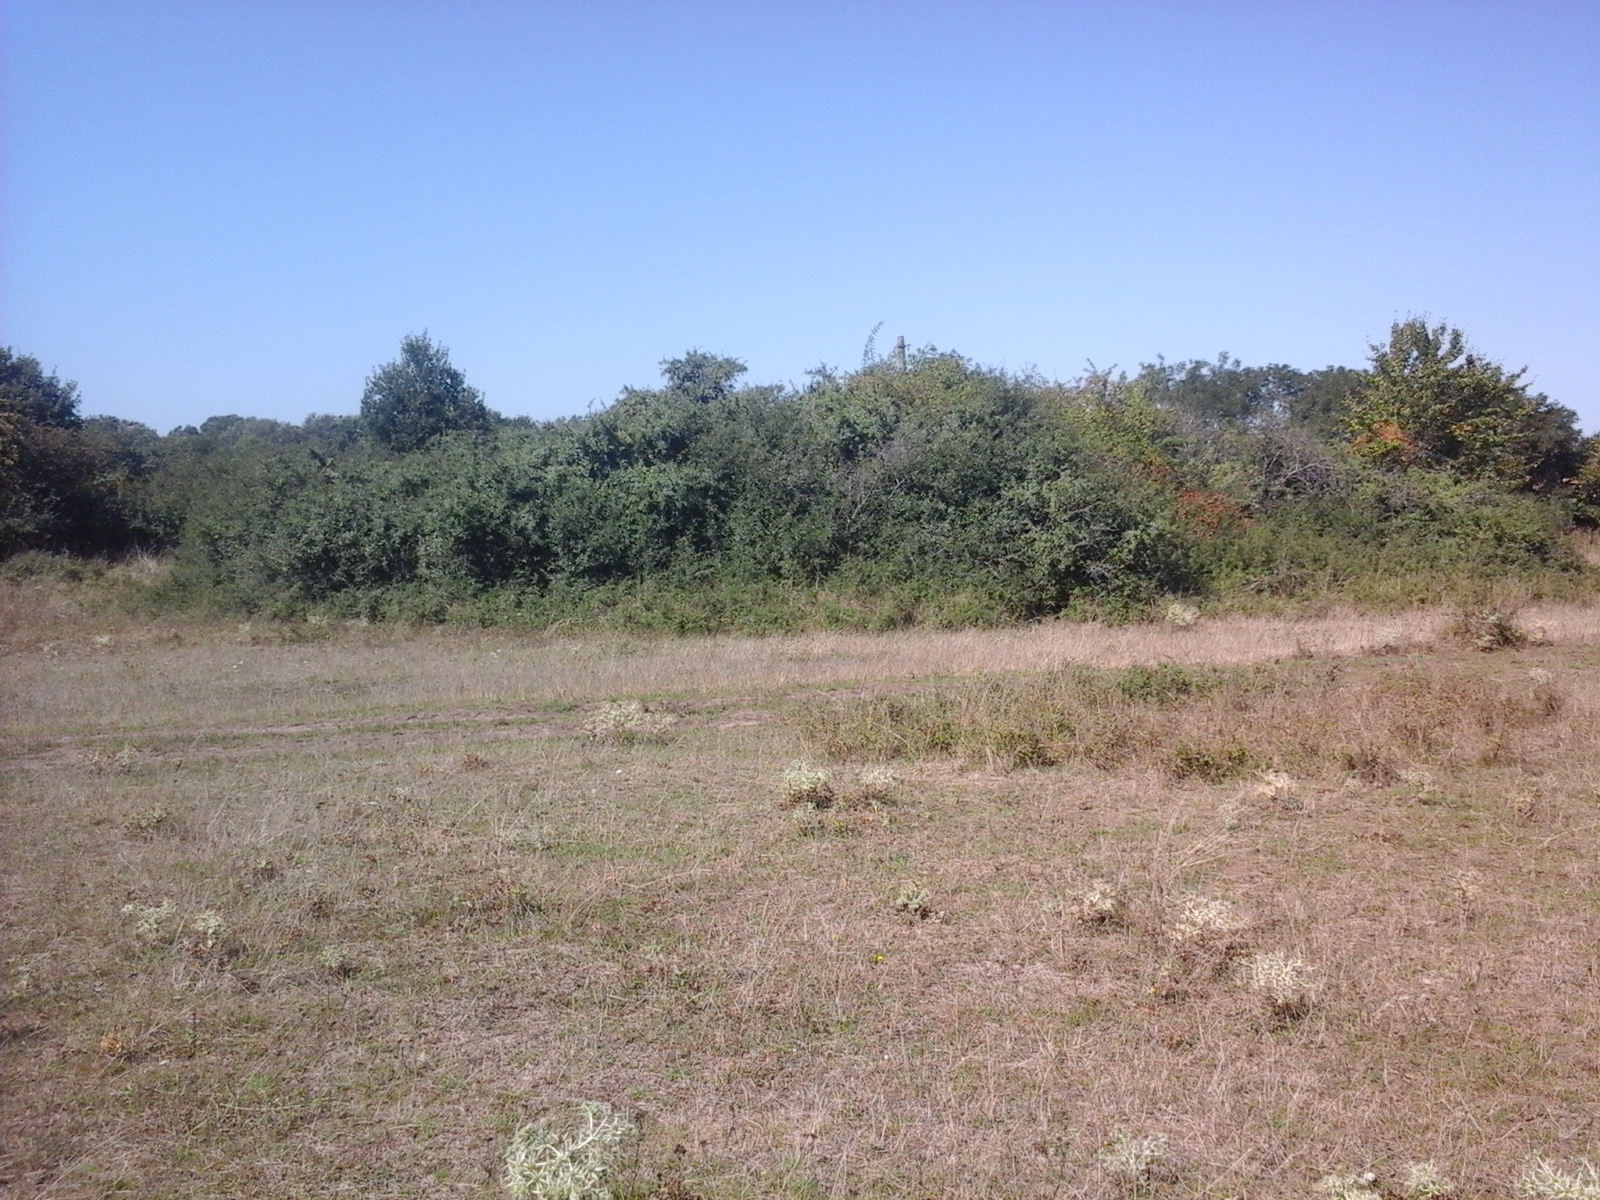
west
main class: Grassland
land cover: Spontaneously vegetated surfaces
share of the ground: > 75 %
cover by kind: herbaceous plants 100 %
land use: Fallow land
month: August
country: RO
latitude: 46.1255
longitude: 21.0177
